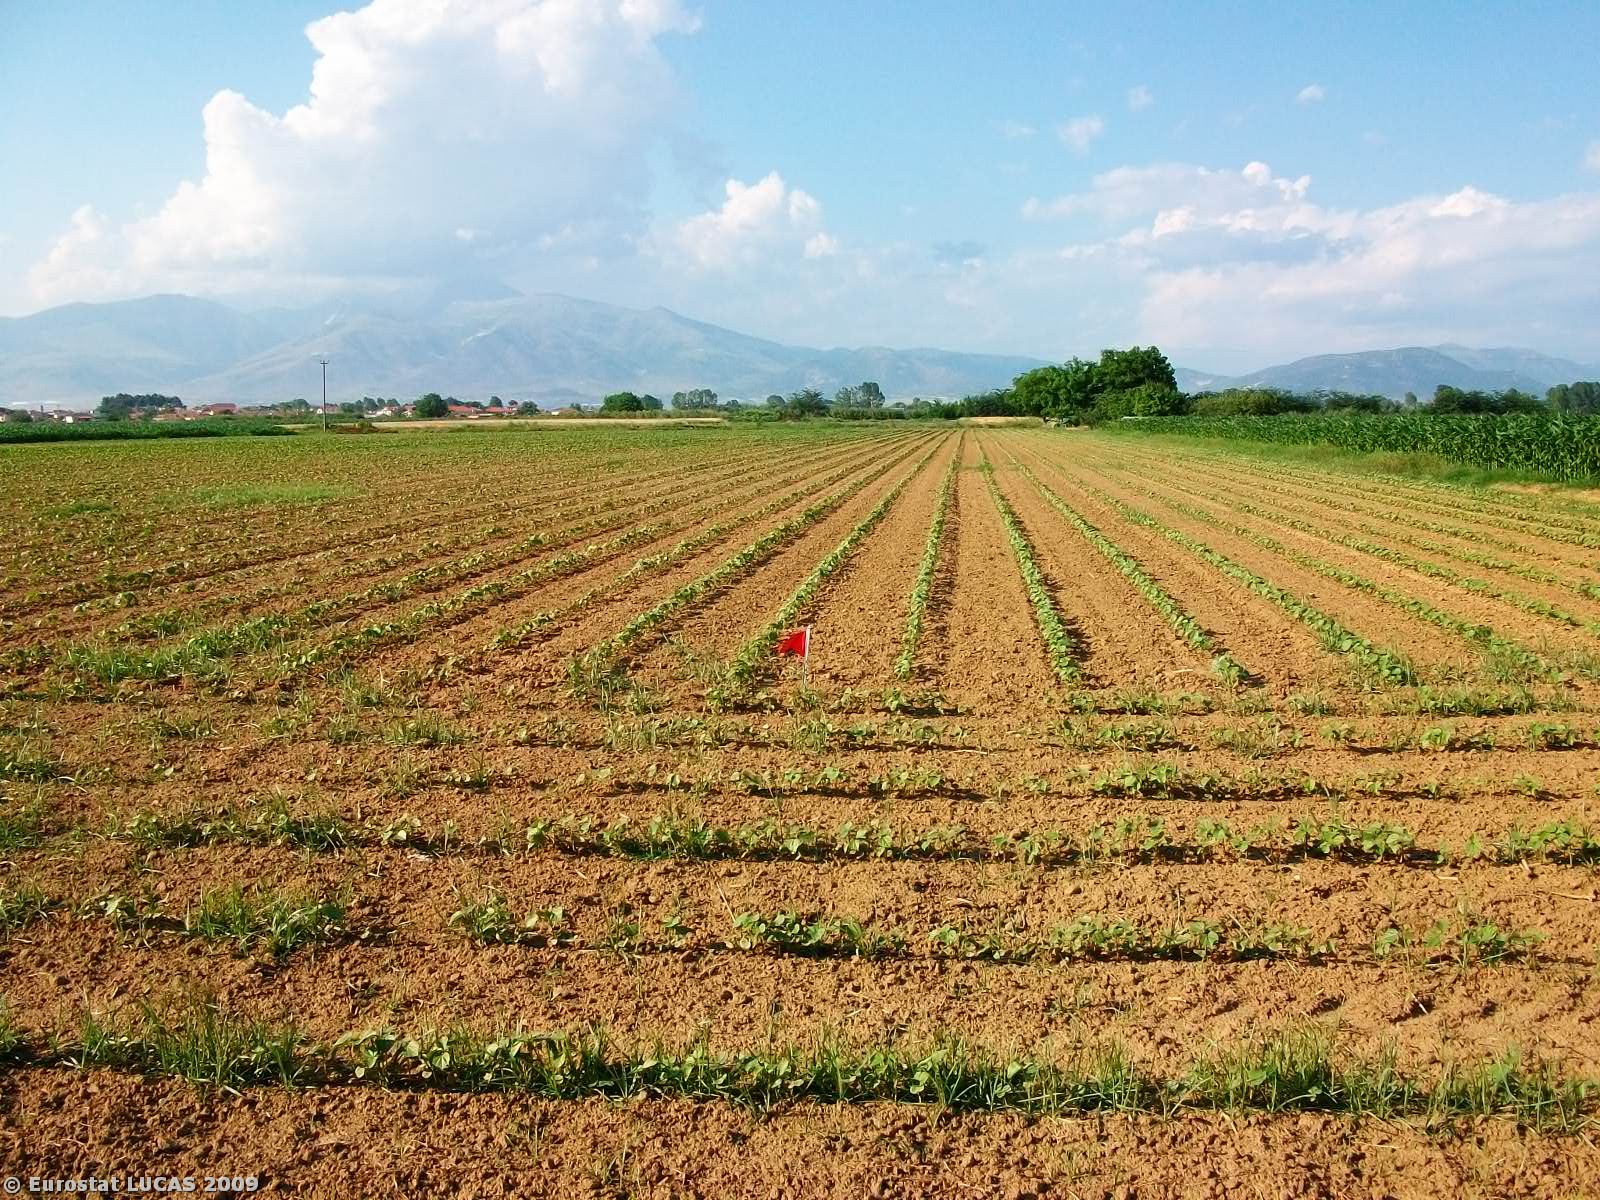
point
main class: Cropland
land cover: Dry pulses
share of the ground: 10 - 25 %
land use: Agriculture (excluding fallow land and kitchen gardens)
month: June
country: GR
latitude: 41.0960
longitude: 24.0886
